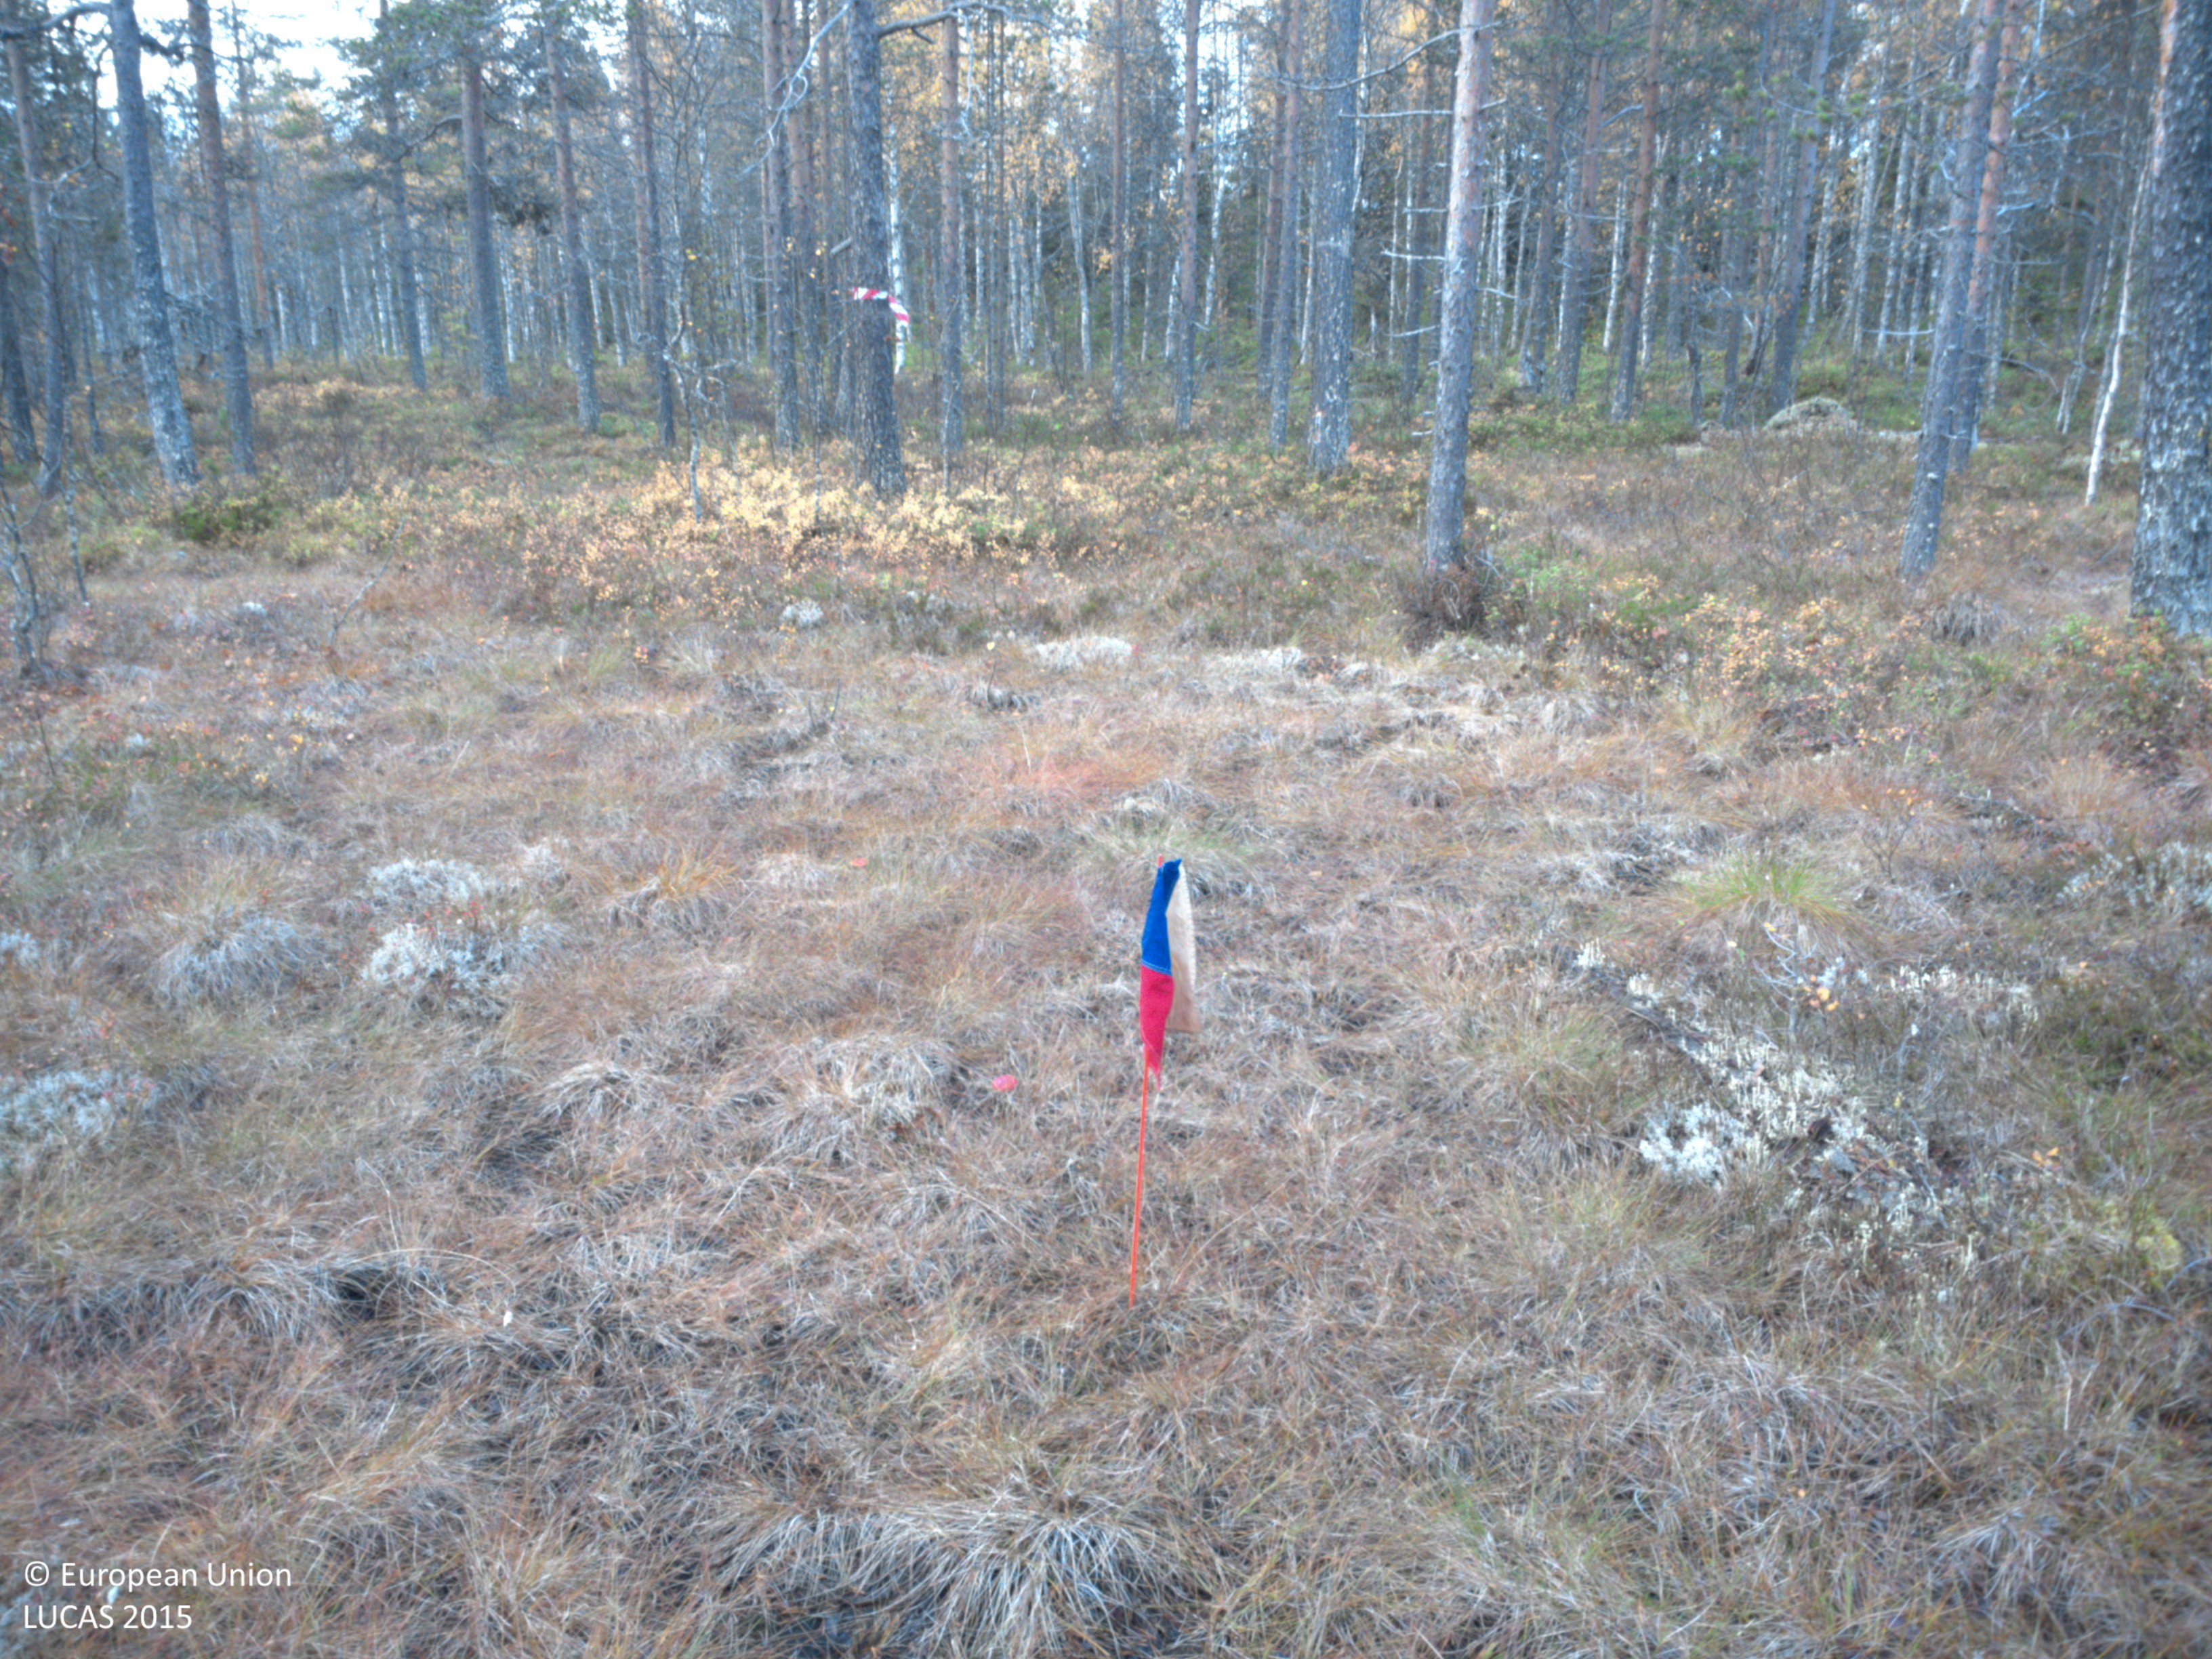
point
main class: Woodland
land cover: Pine dominated coniferous woodland
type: boreal forest
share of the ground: 50 - 75 %
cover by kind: coniferous forest trees 55 %, herbaceous plants 20 %, lichens and mosses 15 %, shrubs 10 %
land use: Forestry
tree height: > 5 m
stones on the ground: < 10 %
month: September
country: SE
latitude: 65.0574
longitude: 18.5711
